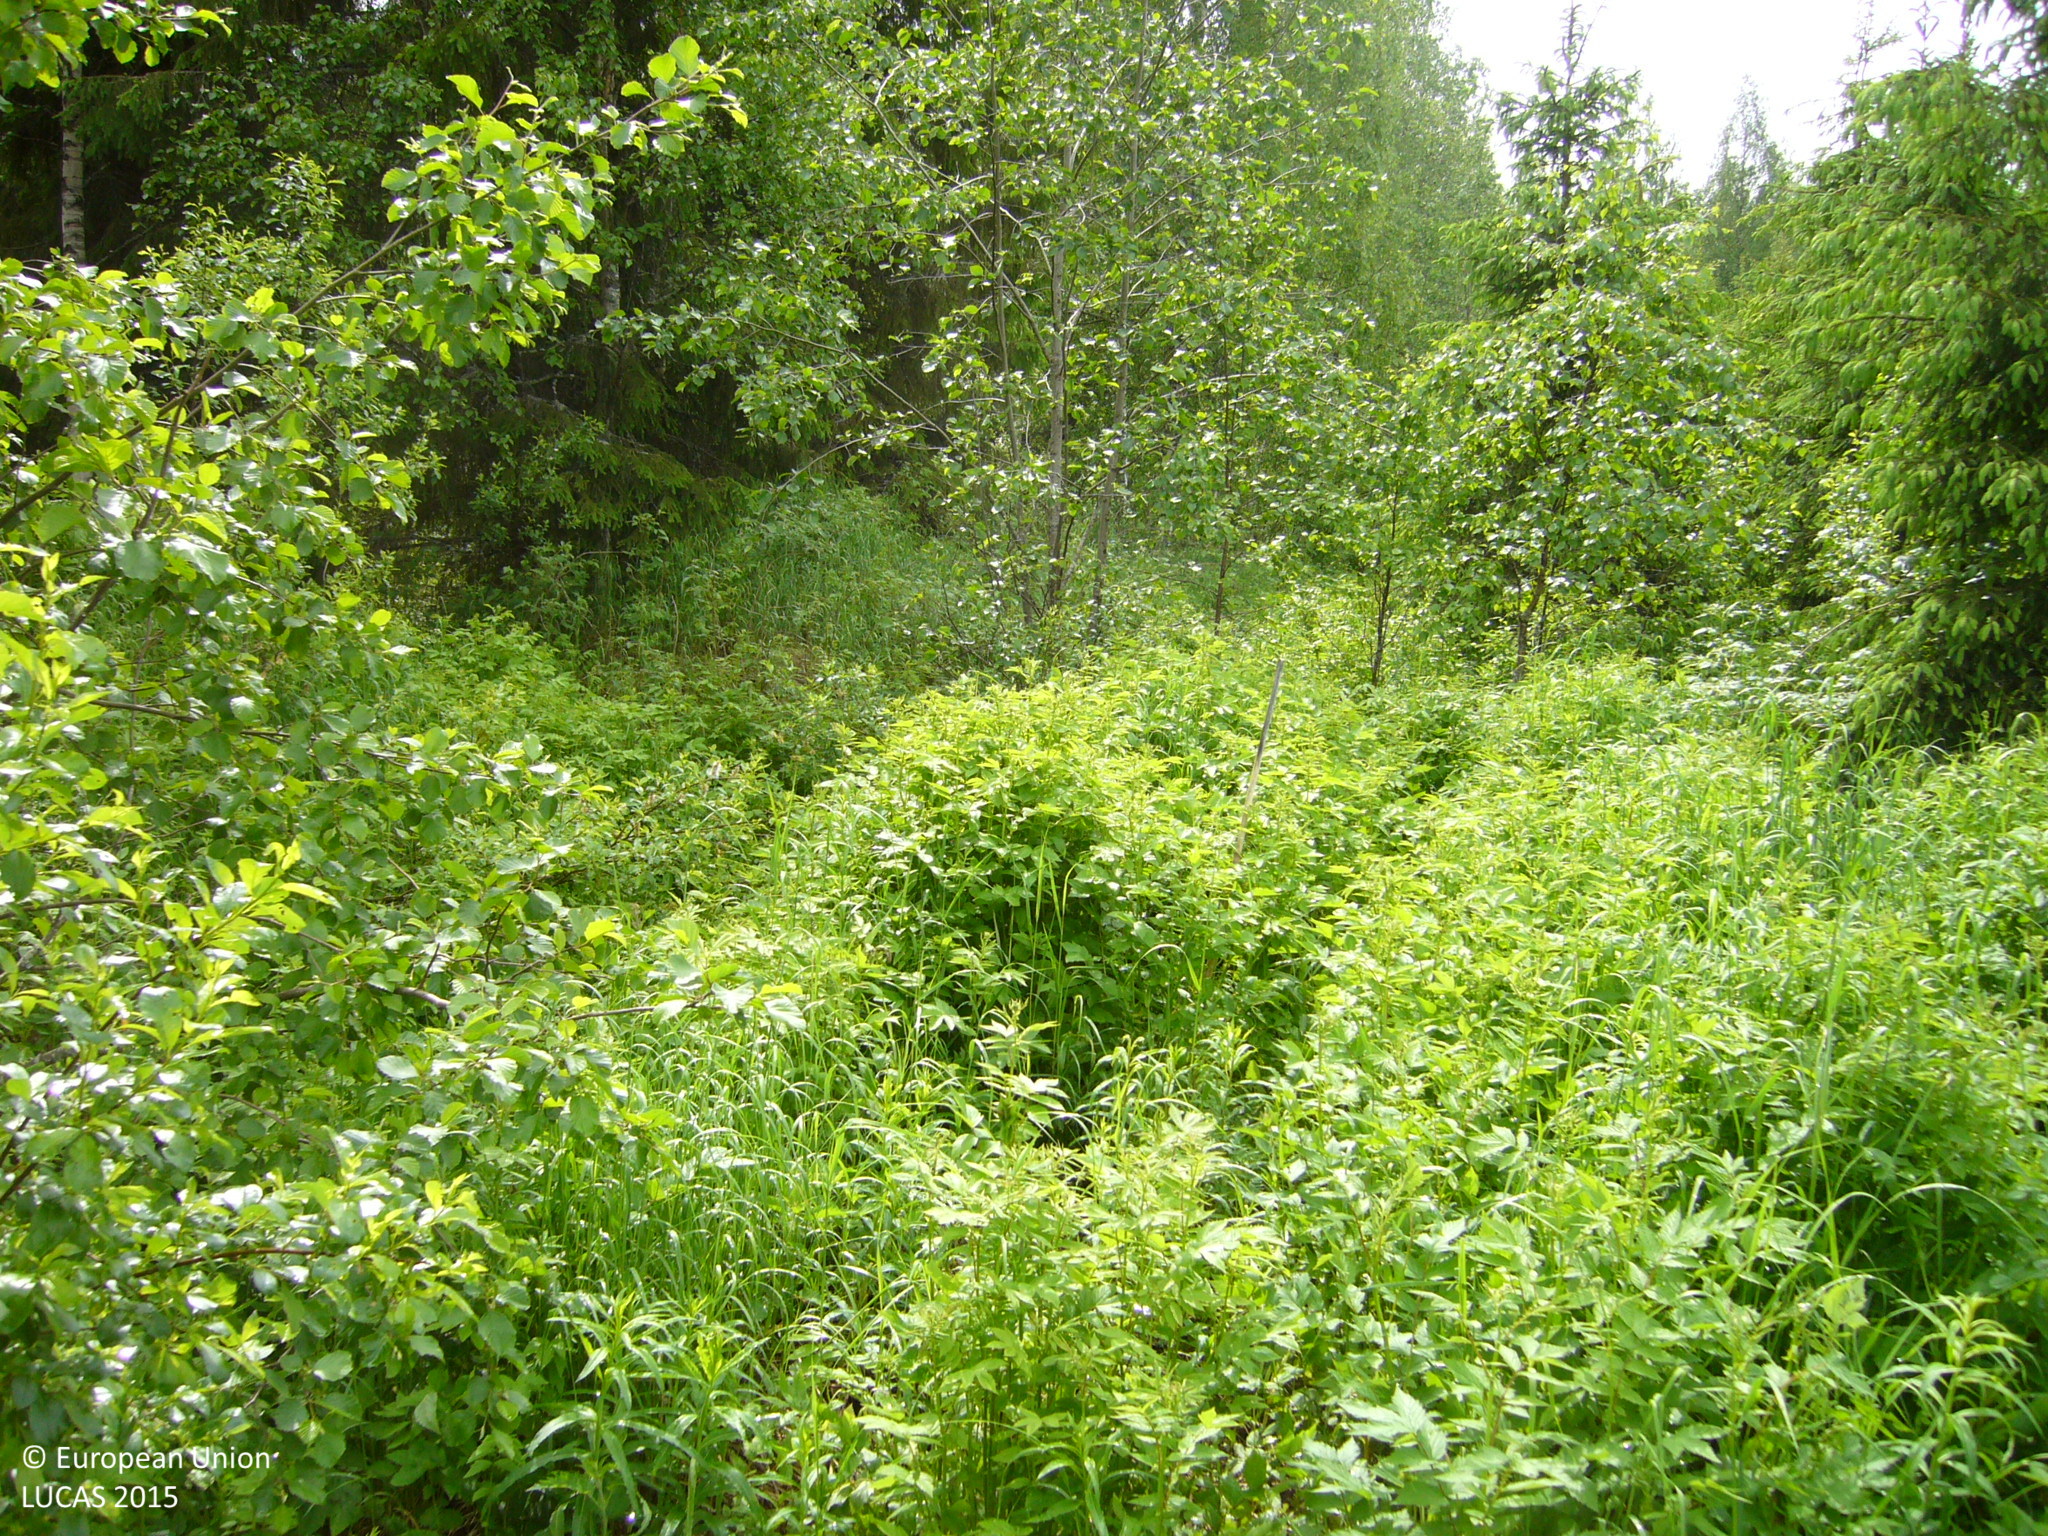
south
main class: Woodland
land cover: Spruce dominated mixed woodland
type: boreal forest
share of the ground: 50 - 75 %
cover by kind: coniferous forest trees 40 %, herbaceous plants 35 %, broadleaved forest trees 25 %
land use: Forestry
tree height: > 5 m
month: June
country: FI
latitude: 63.7891
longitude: 26.4581
